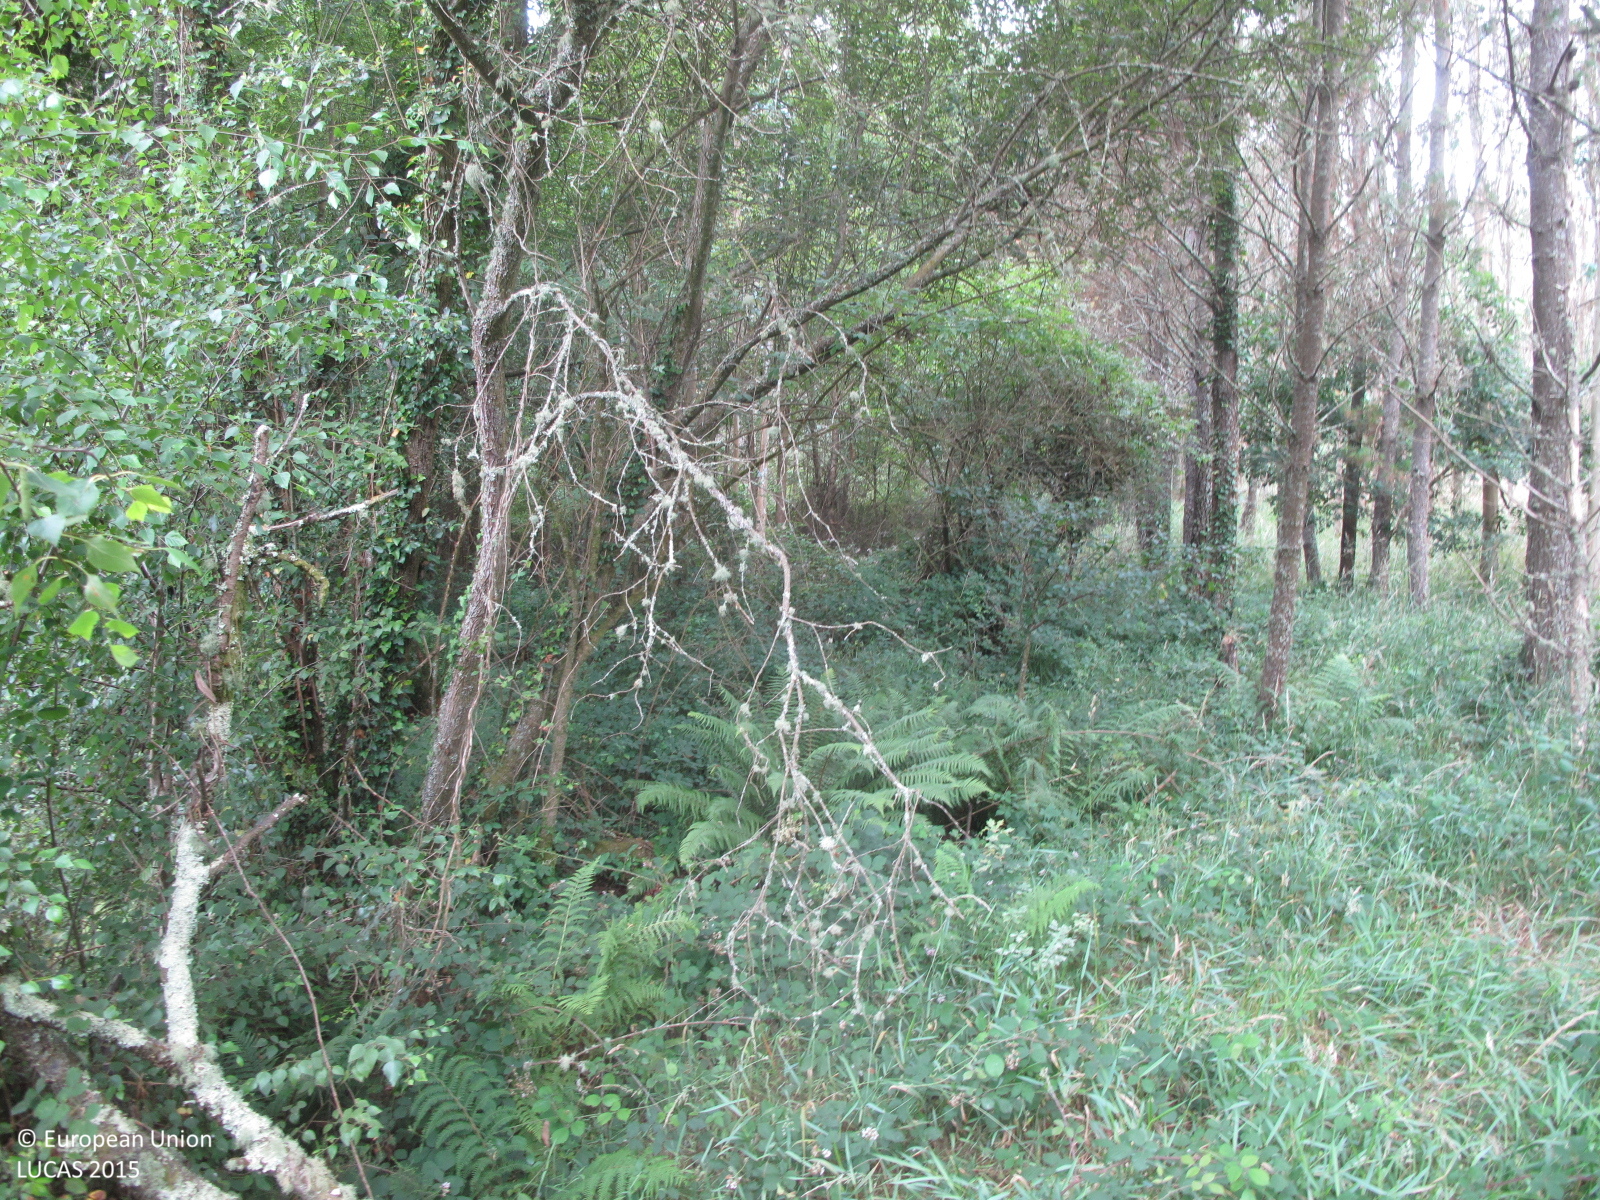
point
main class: Woodland
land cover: Broadleaved woodland
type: acidophilous oak and oak-birch forest
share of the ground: > 75 %
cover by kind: broadleaved forest trees 80 %, shrubs 10 %, herbaceous plants 10 %
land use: Semi-natural and natural areas not in use
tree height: > 5 m
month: July
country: ES
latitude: 43.4303
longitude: -8.0714
